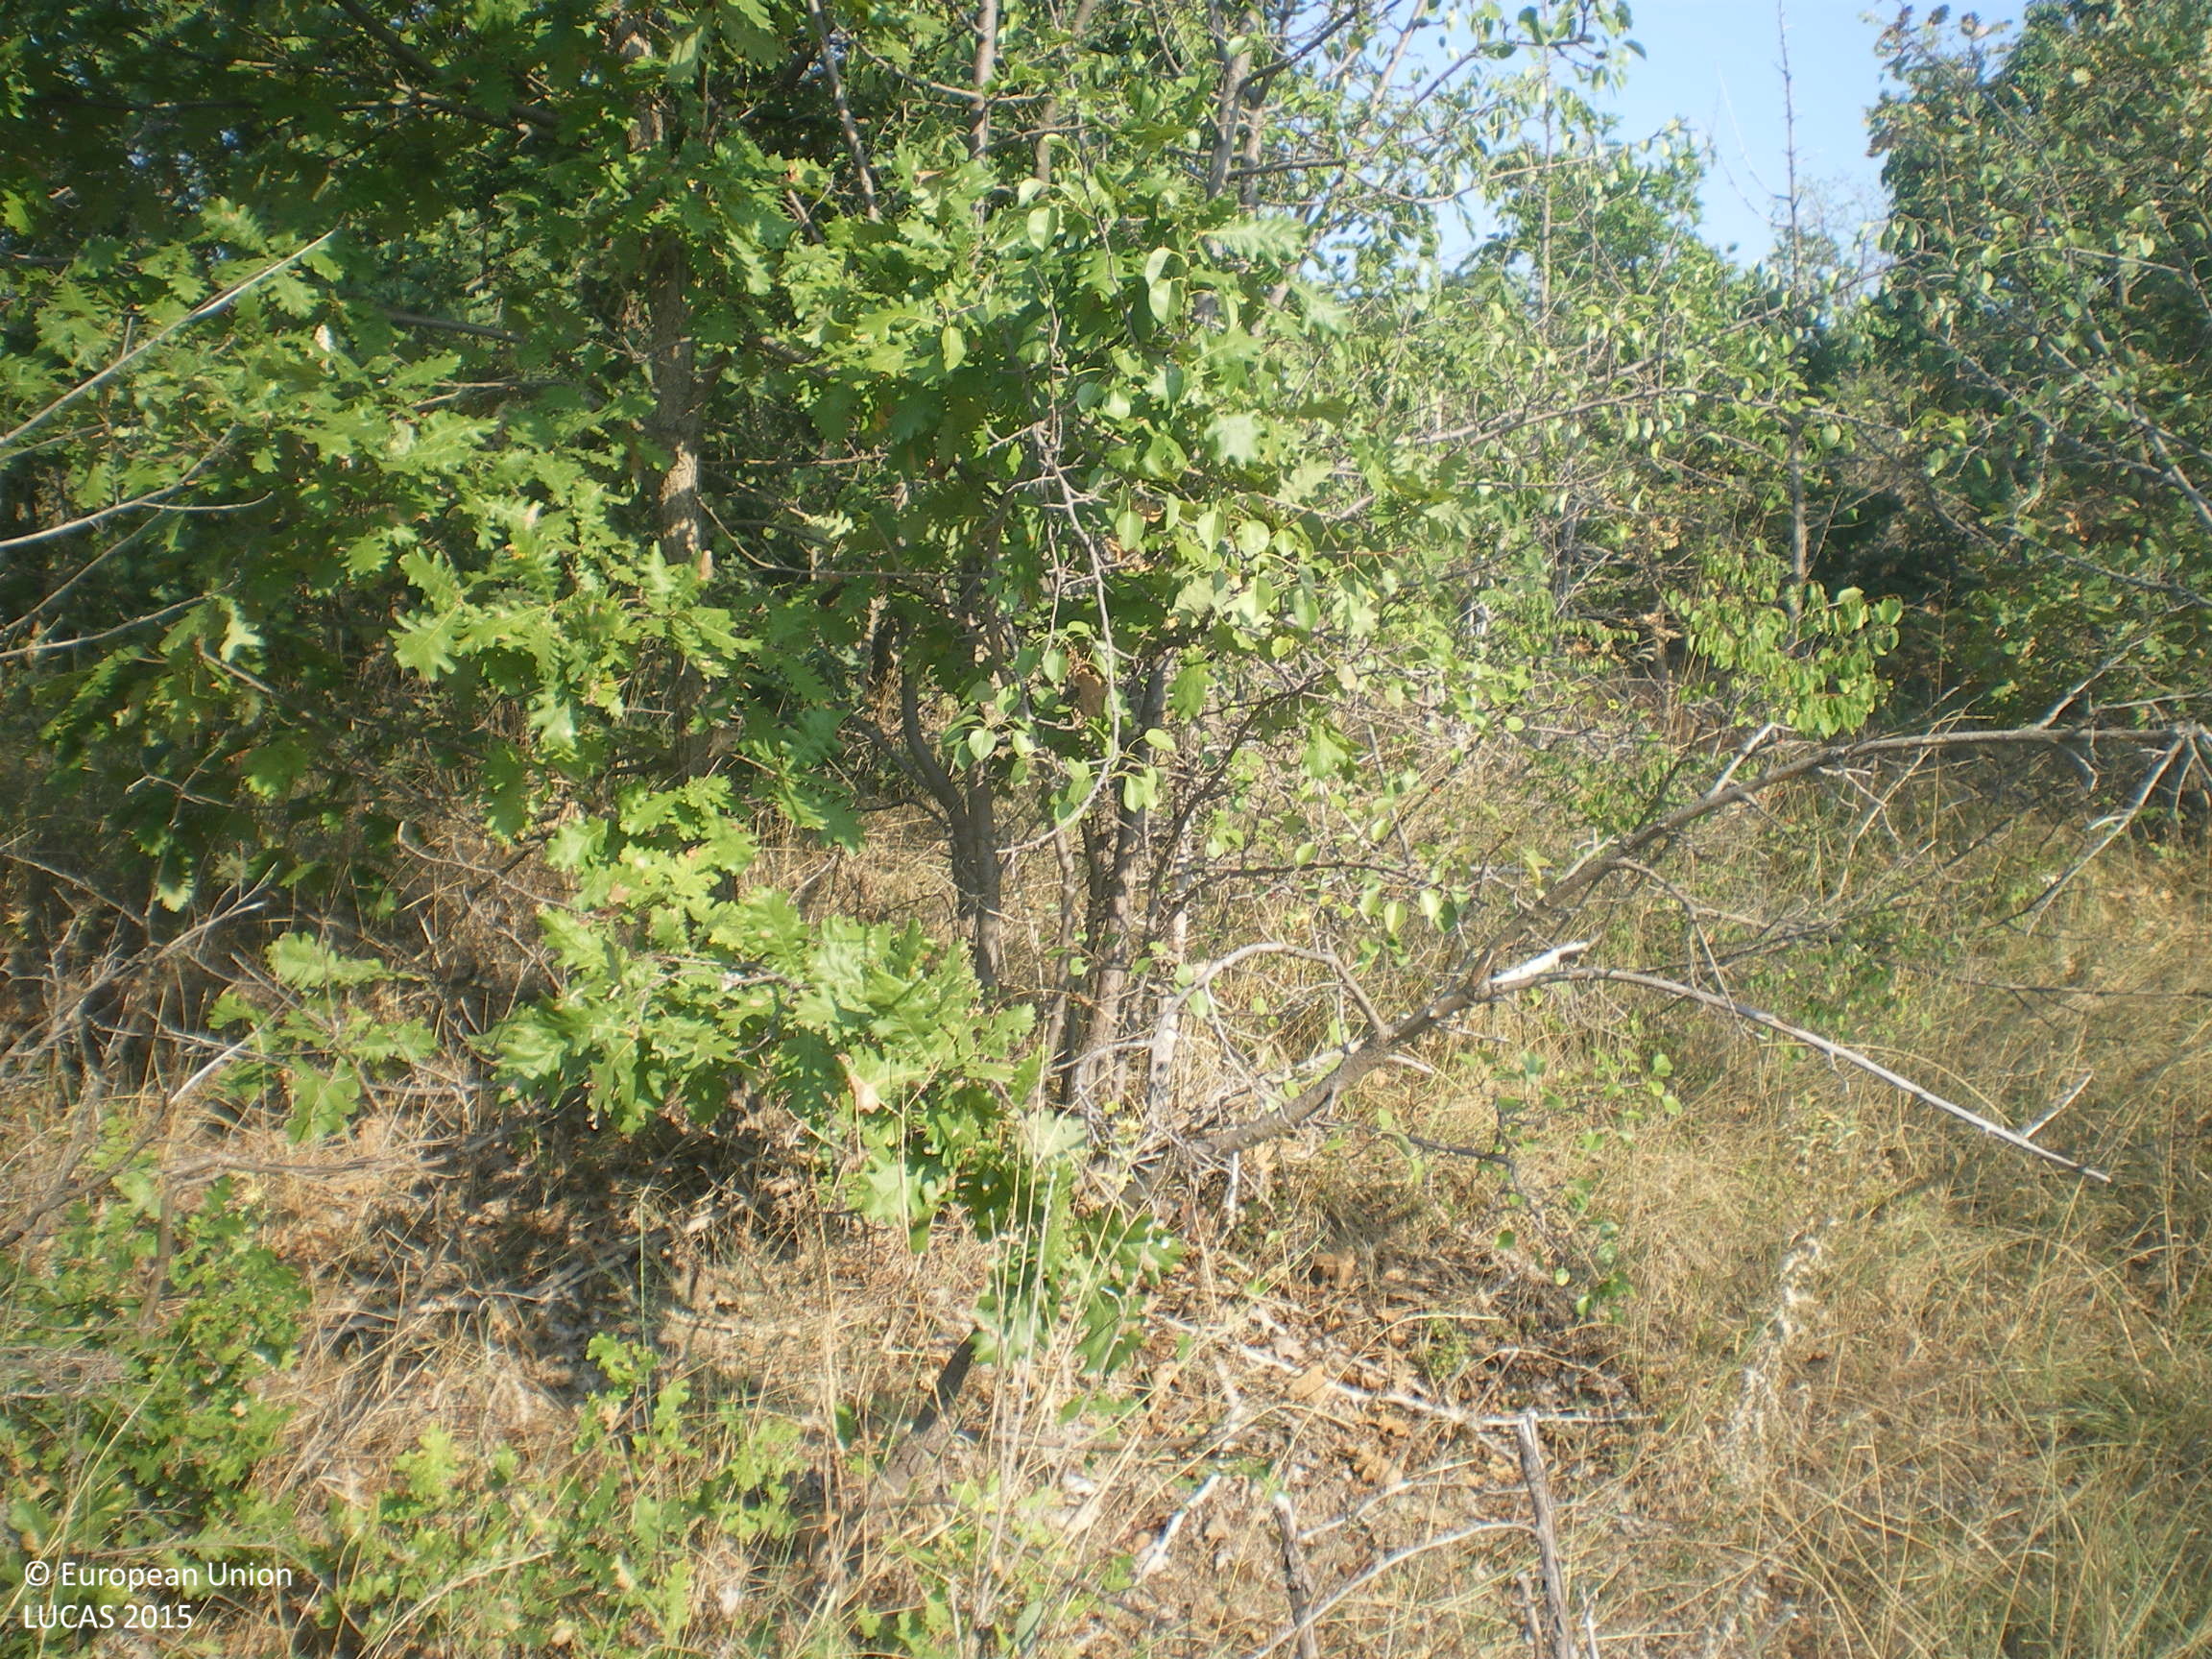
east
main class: Woodland
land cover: Broadleaved woodland
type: acidophilous oak and oak-birch forest
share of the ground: 10 - 25 %
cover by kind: shrubs 80 %, broadleaved forest trees 20 %
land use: Forestry
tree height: > 5 m
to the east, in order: Broadleaved woodland
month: August
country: BG
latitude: 41.9083
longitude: 25.7522
